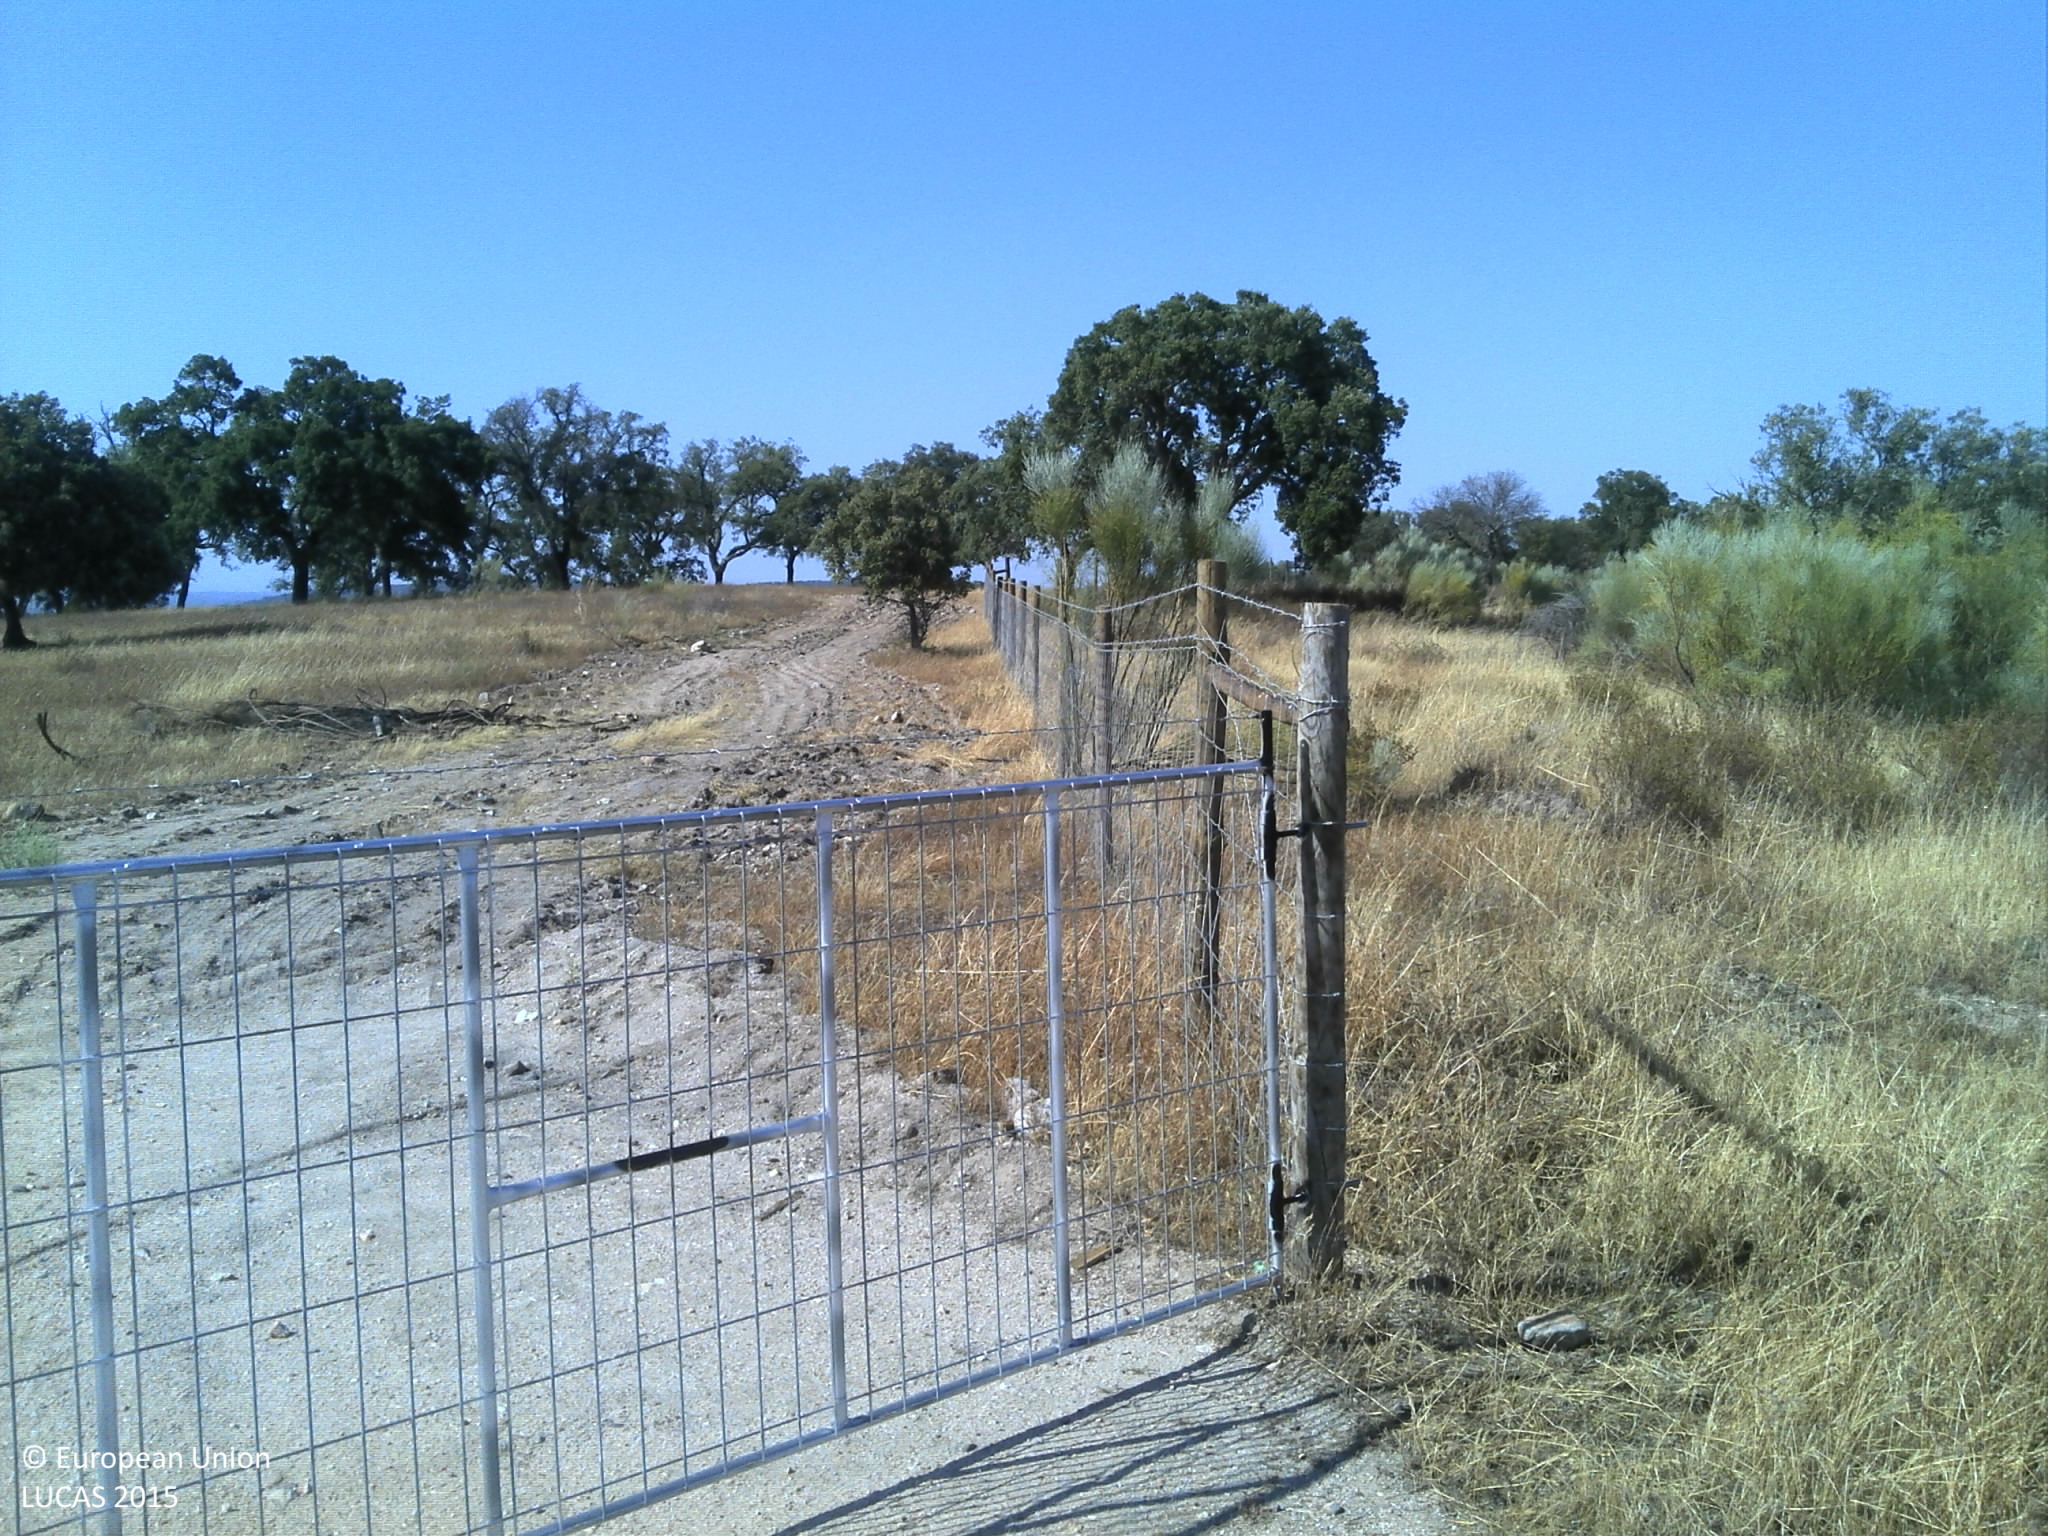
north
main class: Woodland
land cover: Broadleaved woodland
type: broadleaved evergreen forest
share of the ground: 25 - 50 %
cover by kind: herbaceous plants 55 %, broadleaved forest trees 45 %
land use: Forestry
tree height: > 5 m
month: June
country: PT
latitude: 39.7234
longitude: -7.3483
